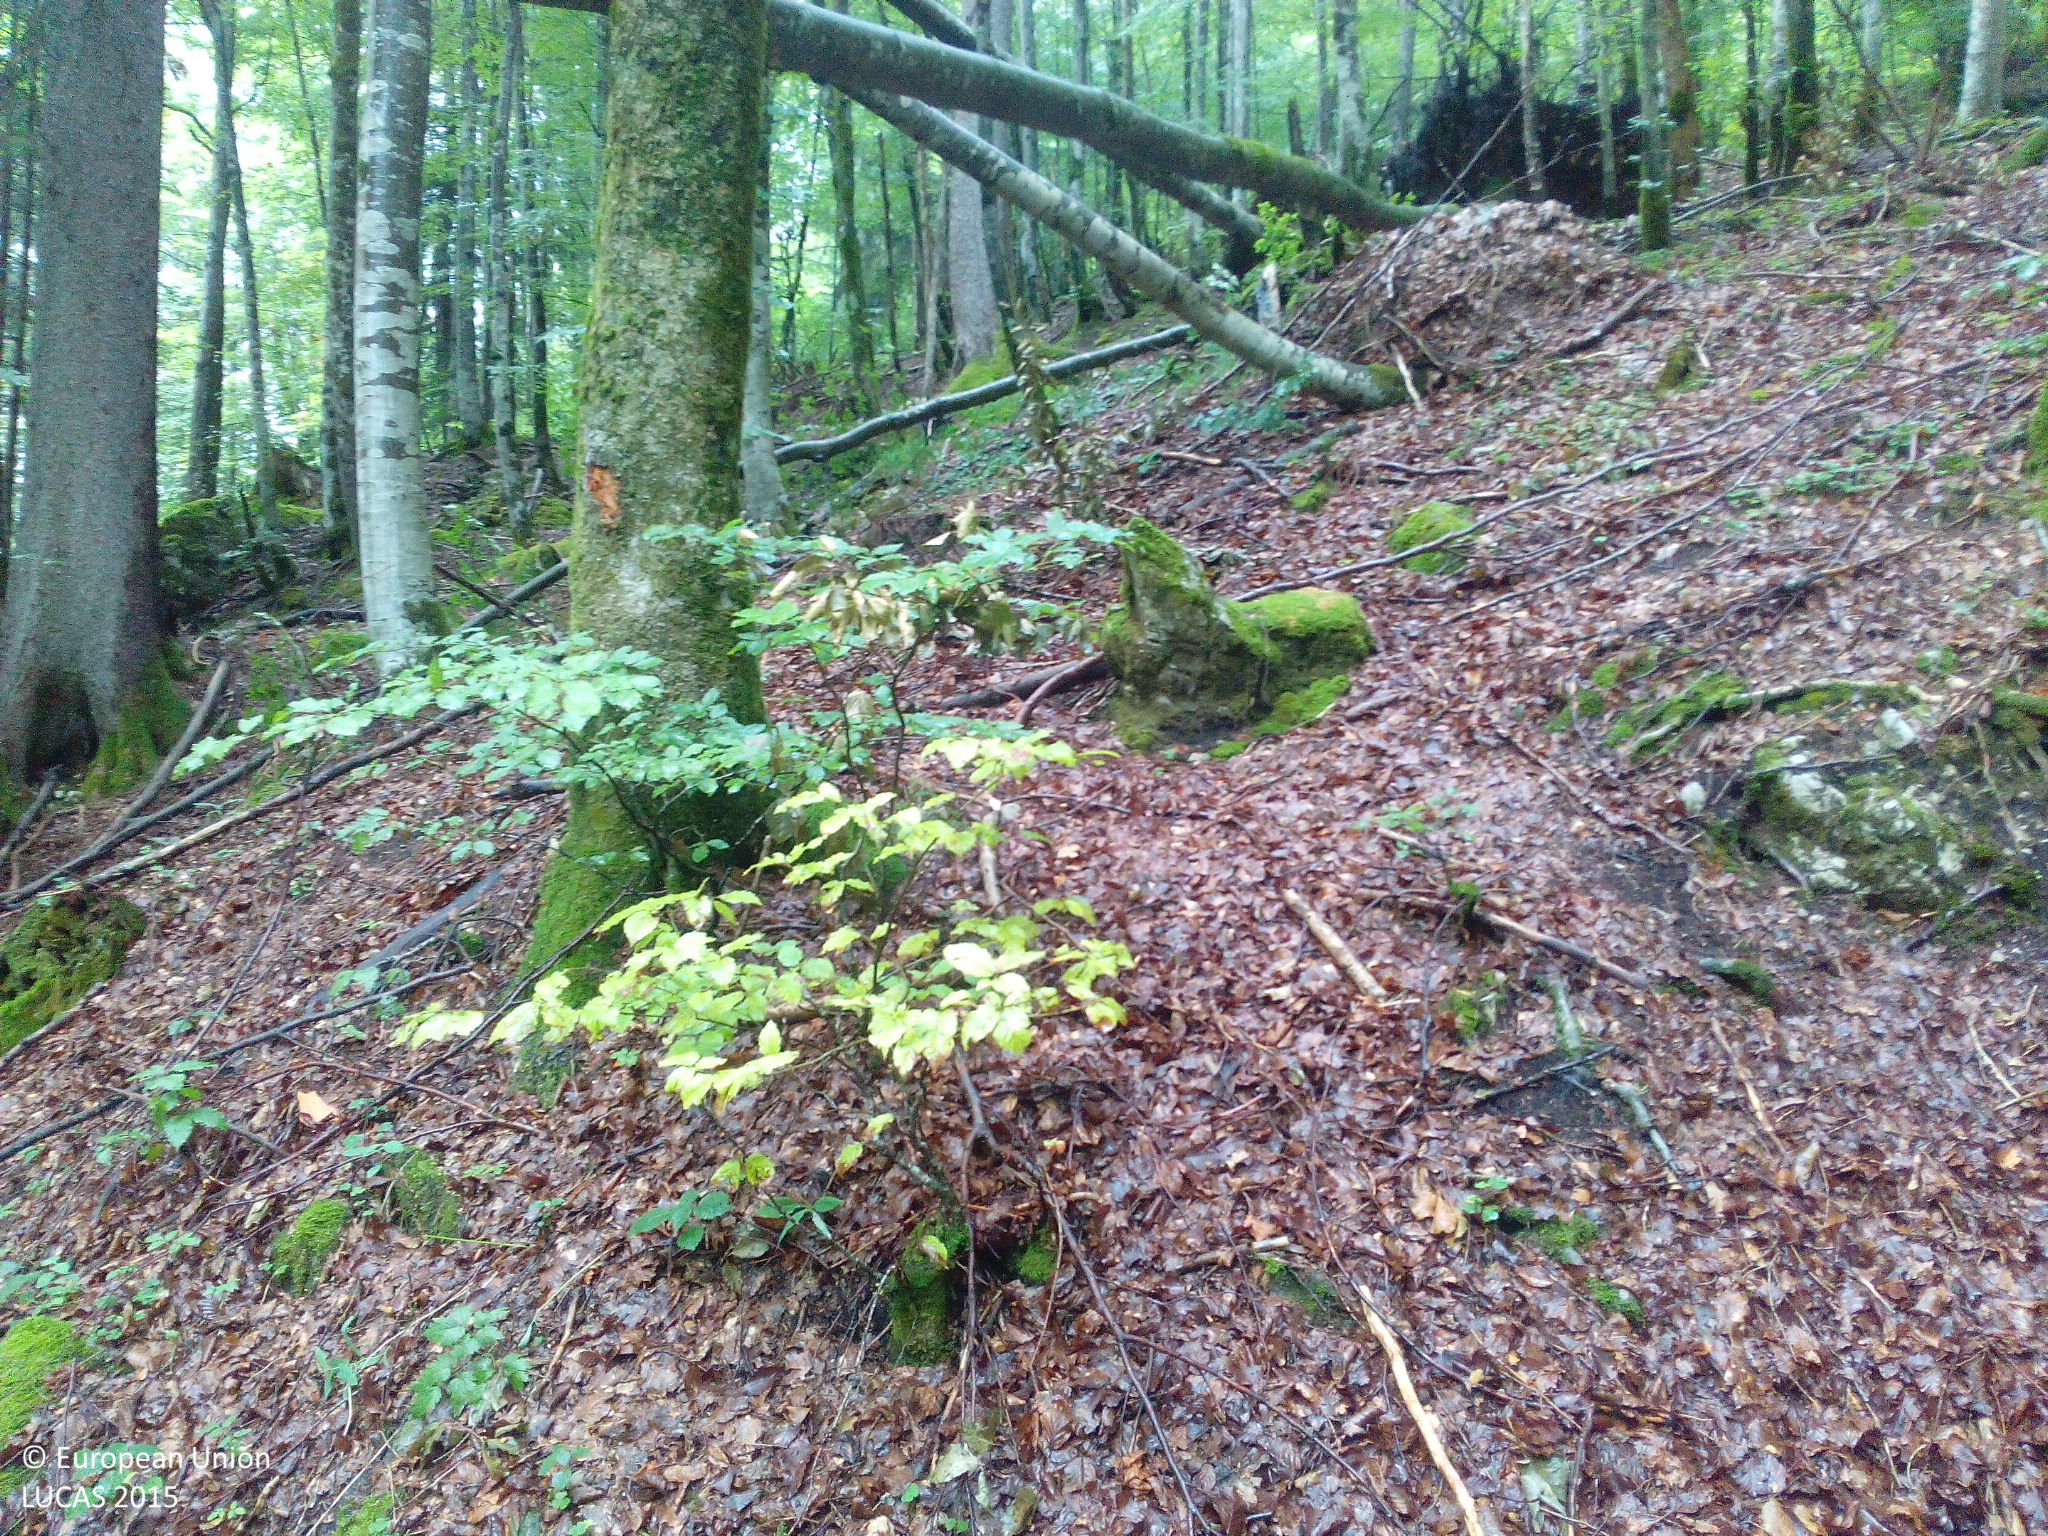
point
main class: Woodland
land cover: Broadleaved woodland
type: mesophytic deciduous forest
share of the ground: > 75 %
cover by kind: broadleaved forest trees 100 %
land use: Forestry
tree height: > 5 m
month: July
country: DE
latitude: 47.3592
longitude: 10.3042
